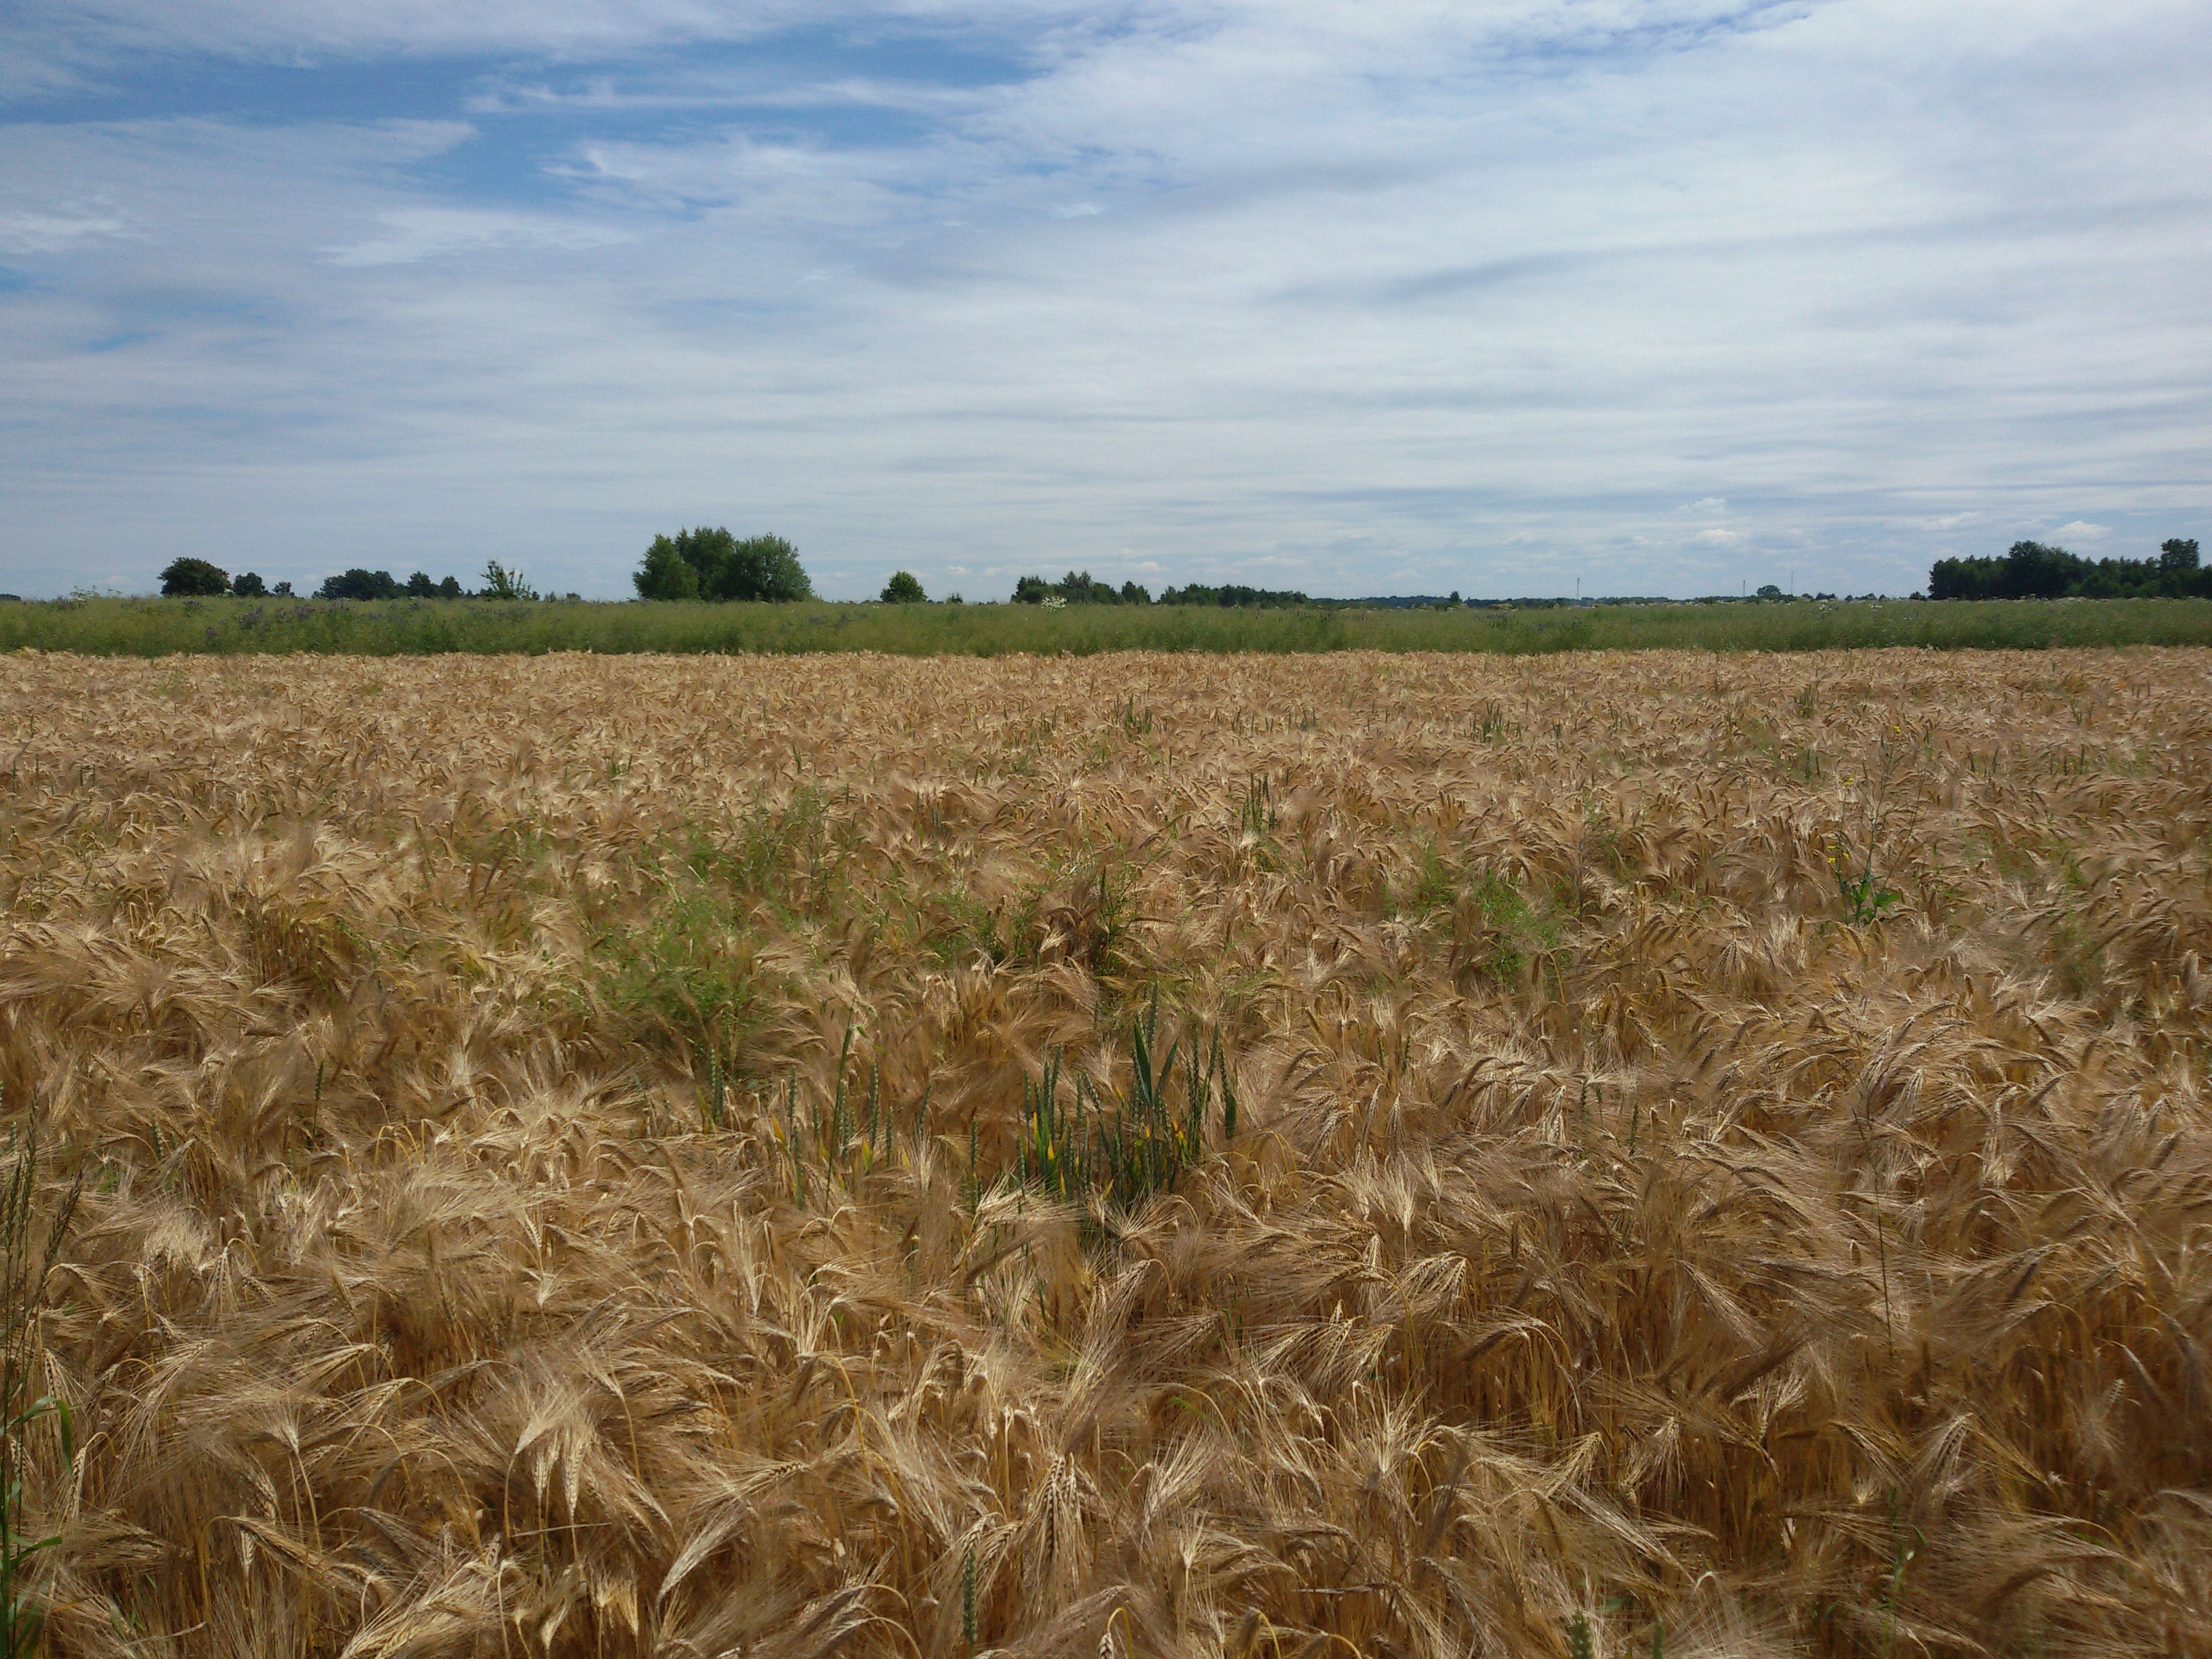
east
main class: Cropland
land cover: Barley
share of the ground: > 75 %
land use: Agriculture (excluding fallow land and kitchen gardens)
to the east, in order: Barley; Rape and turnip rape; Common wheat
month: June
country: PL
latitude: 51.7278
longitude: 23.0335
